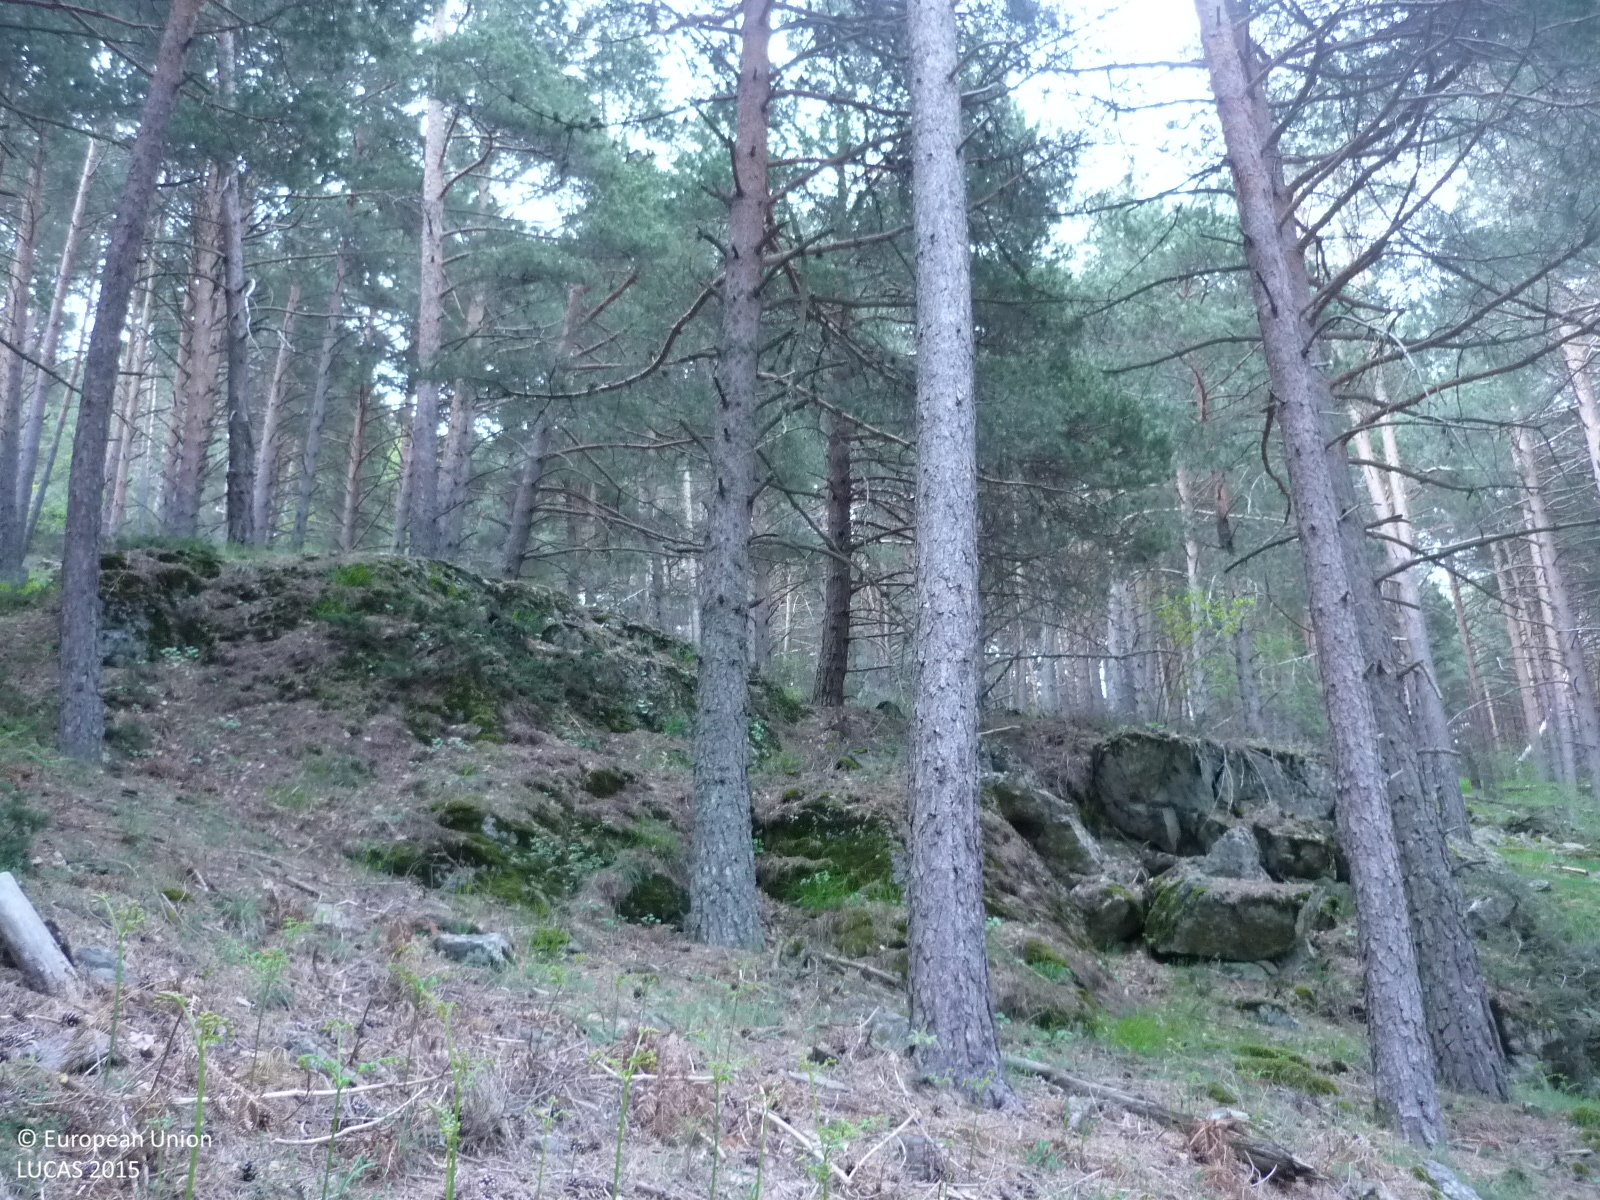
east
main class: Woodland
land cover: Pine dominated coniferous woodland
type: coniferous forest of the mediterranean region
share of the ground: > 75 %
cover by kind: coniferous forest trees 85 %, shrubs 10 %, herbaceous plants 5 %
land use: Forestry
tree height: > 5 m
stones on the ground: 10 - 25 %
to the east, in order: Pine dominated coniferous woodland; Tracks; Pine dominated coniferous woodland; Rocks and stones
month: May
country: ES
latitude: 41.0635
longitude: -3.6707
